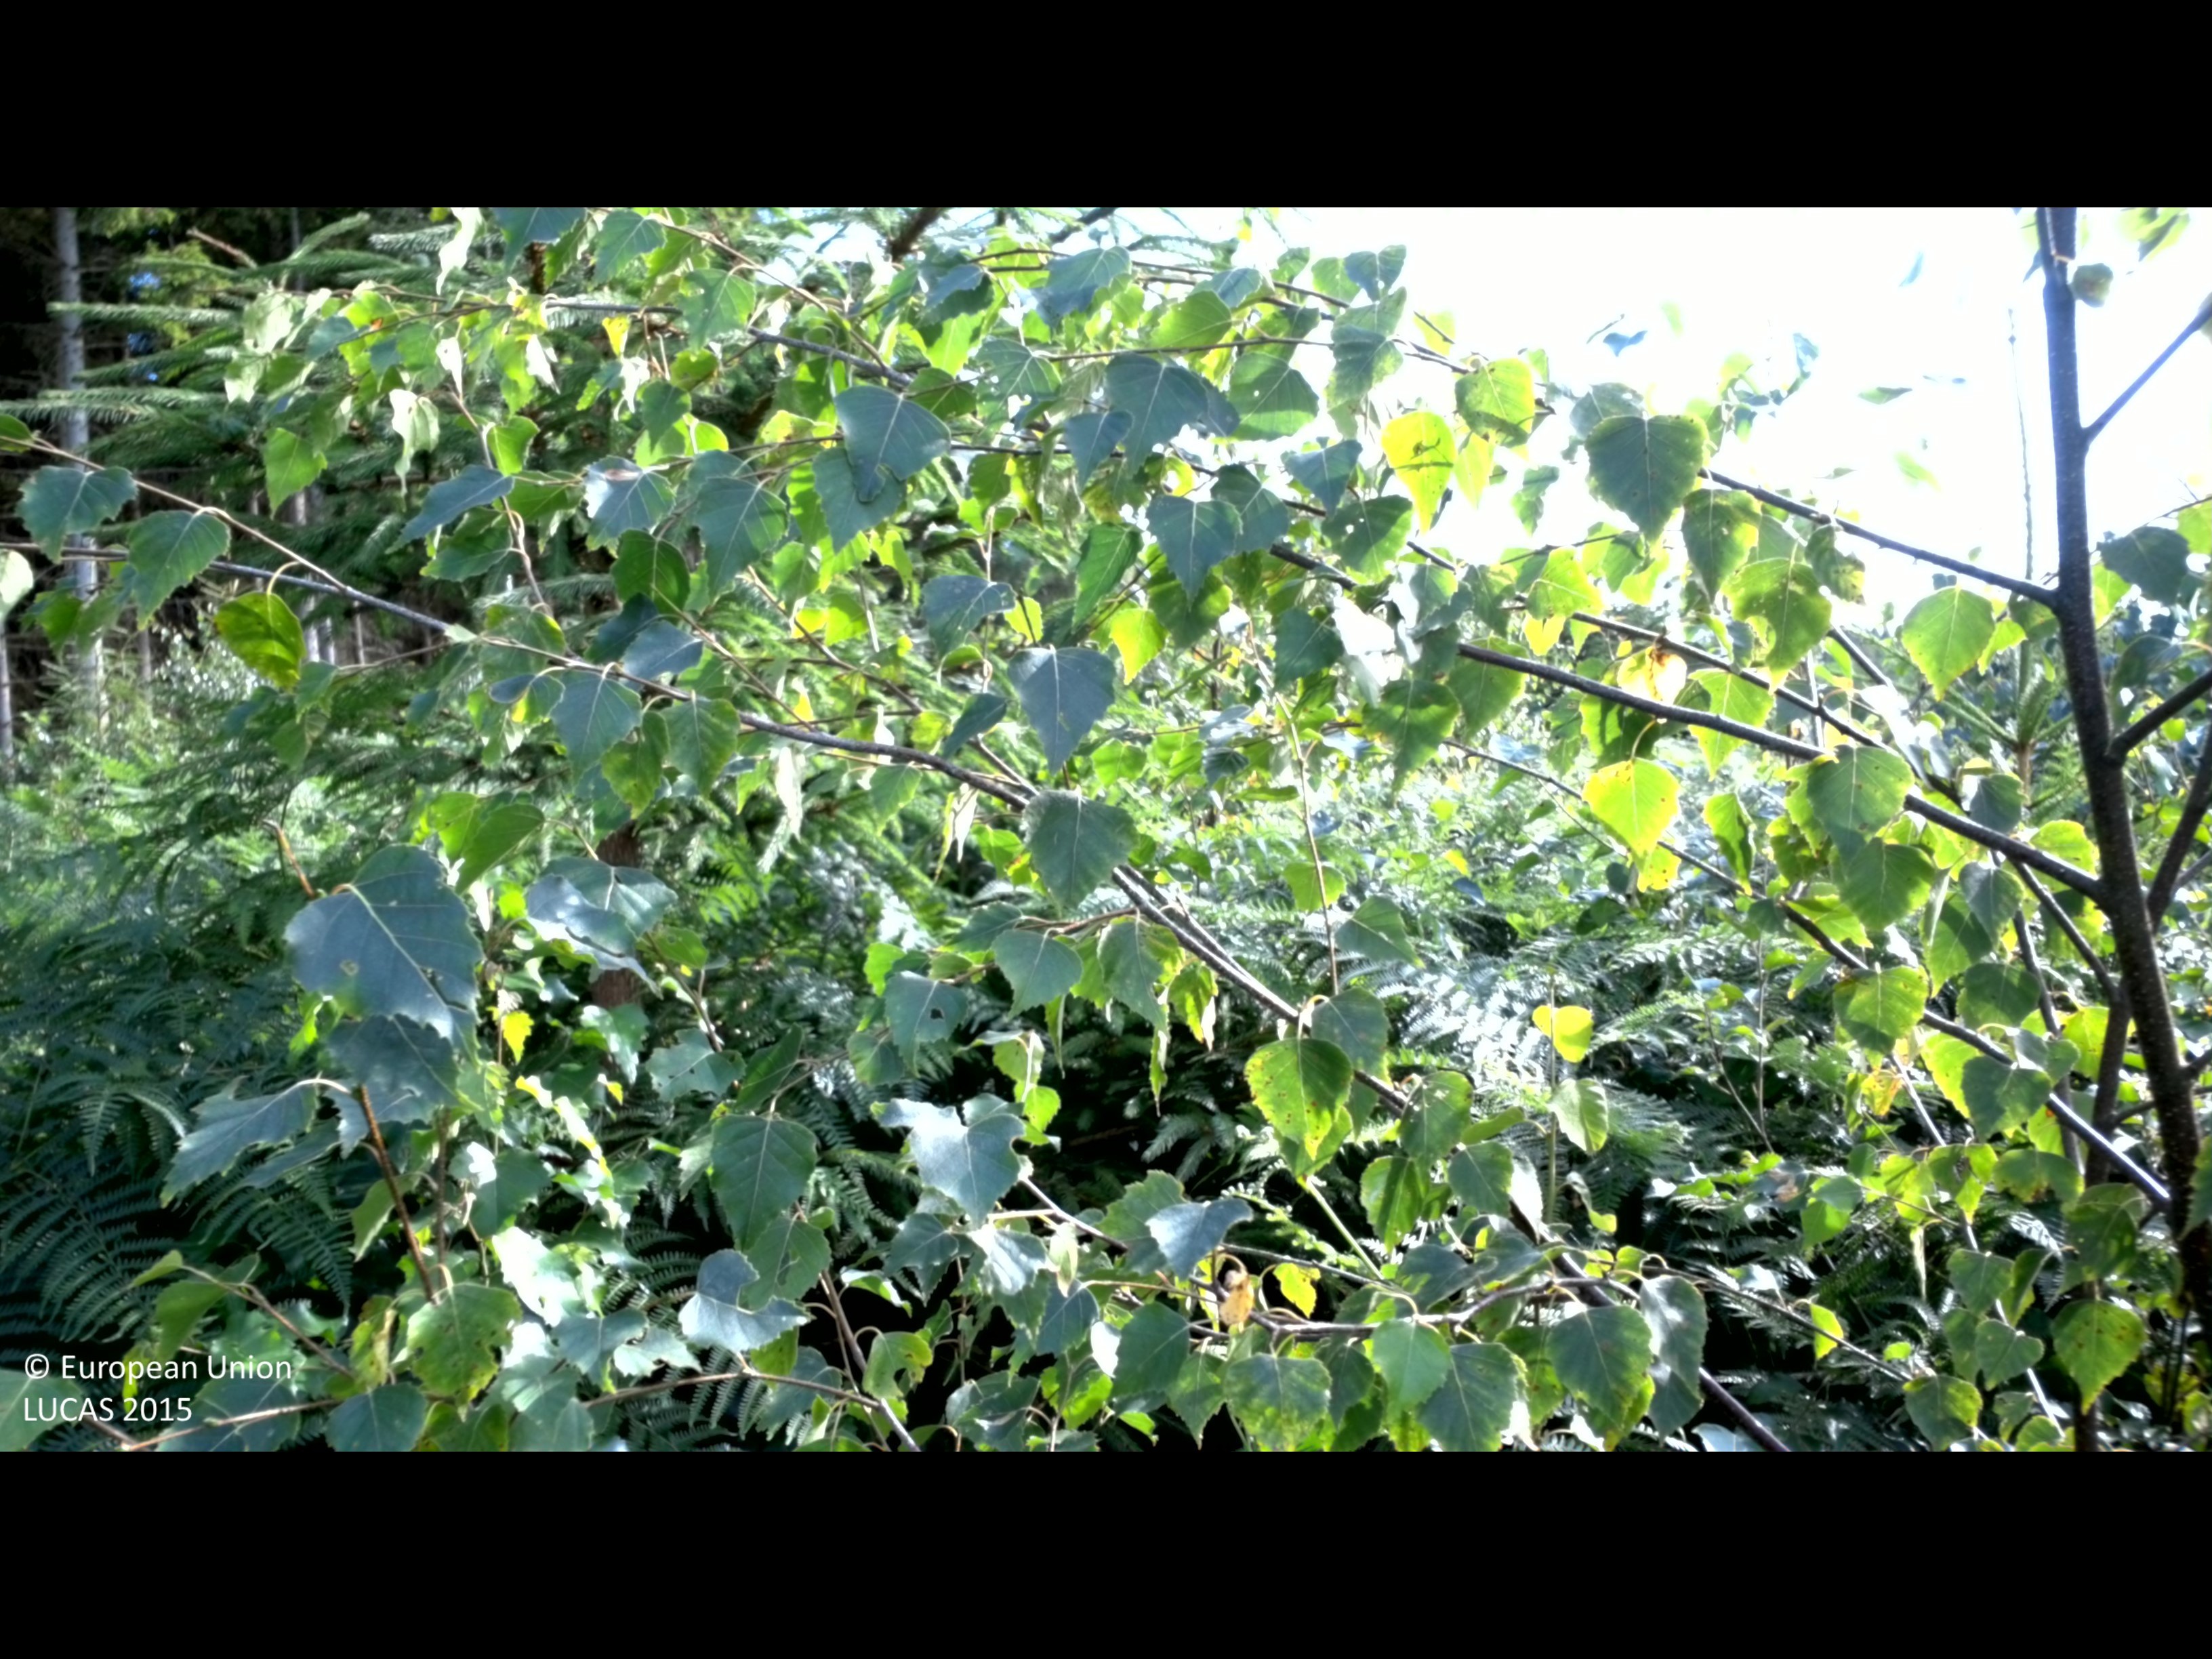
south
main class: Woodland
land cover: Spruce dominated mixed woodland
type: boreal forest
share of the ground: 50 - 75 %
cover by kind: herbaceous plants 50 %, coniferous forest trees 35 %, broadleaved forest trees 15 %
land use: Forestry
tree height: < 5 m
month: August
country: SE
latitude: 56.2194
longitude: 15.7896
